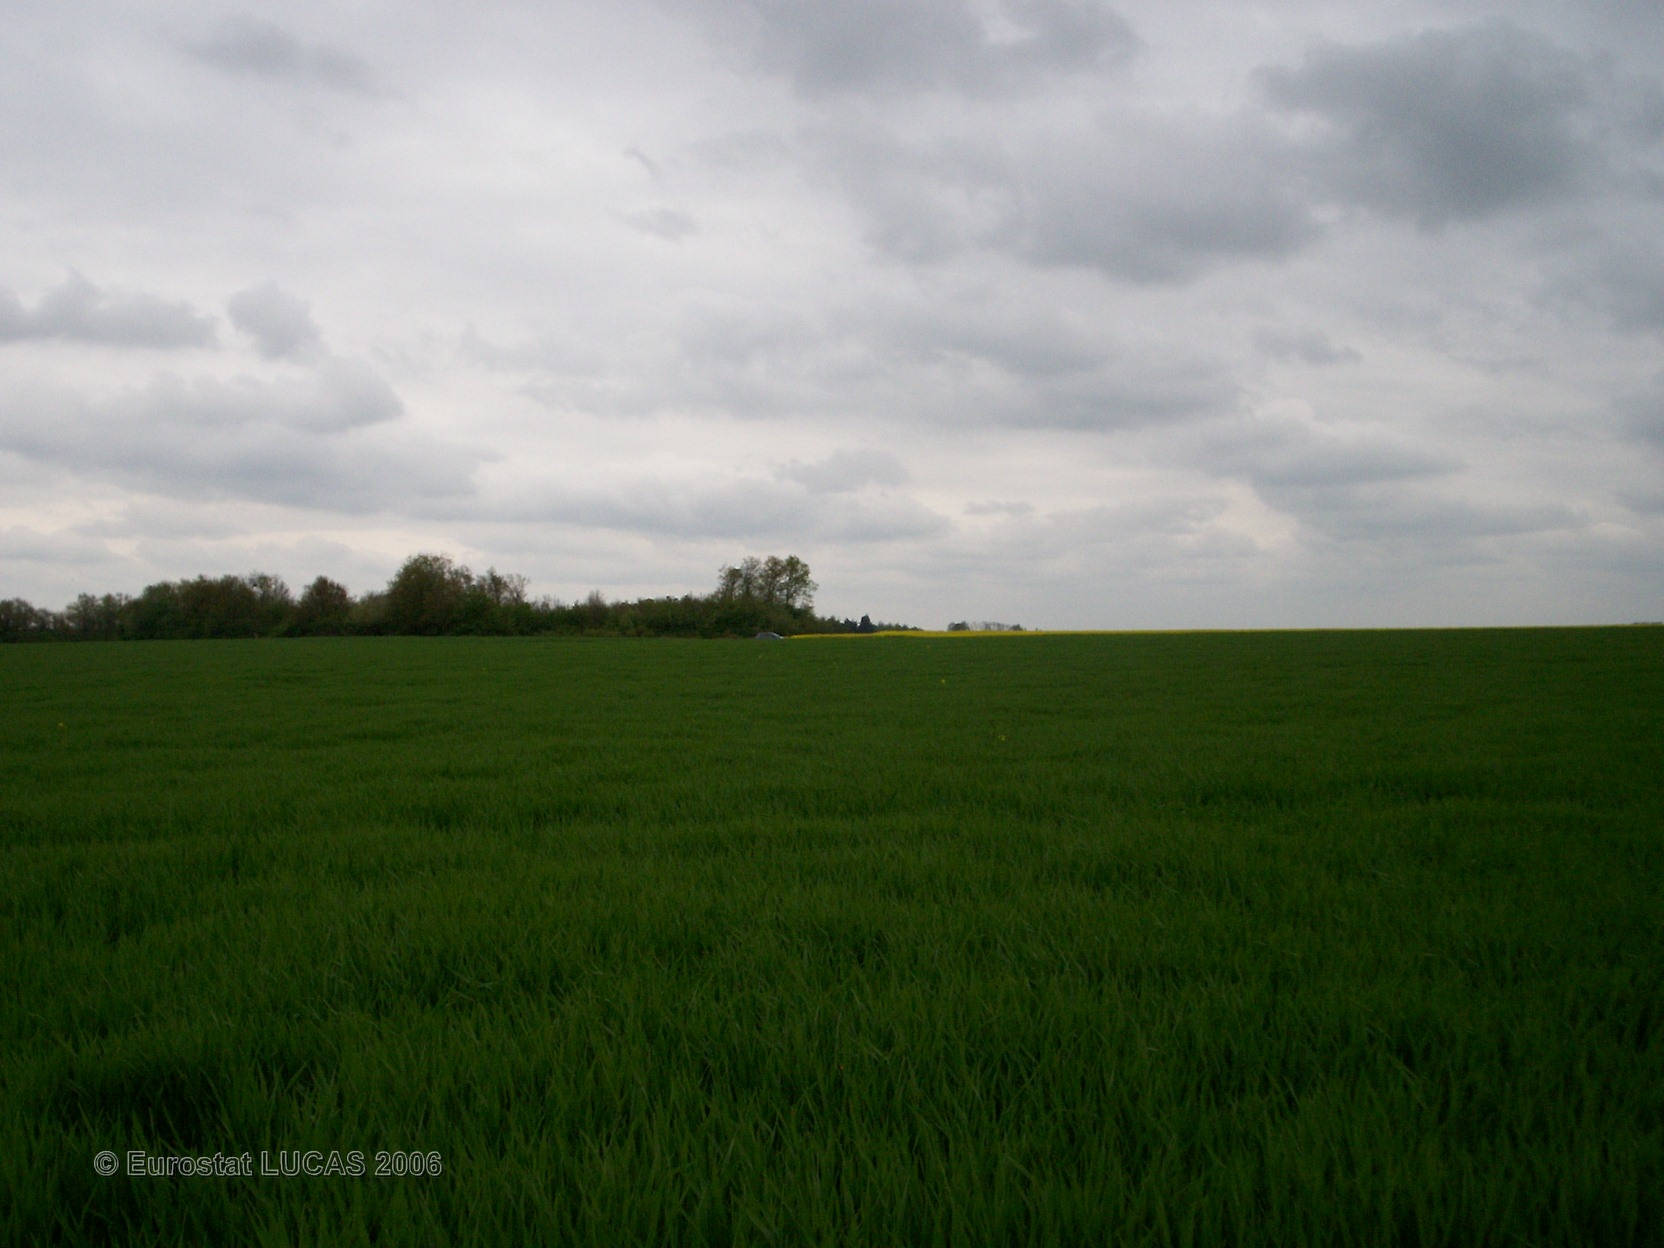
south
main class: Cropland
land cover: Barley
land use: Agriculture (excluding fallow land and kitchen gardens)
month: May
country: FR
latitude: 48.2113
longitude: 2.8999
